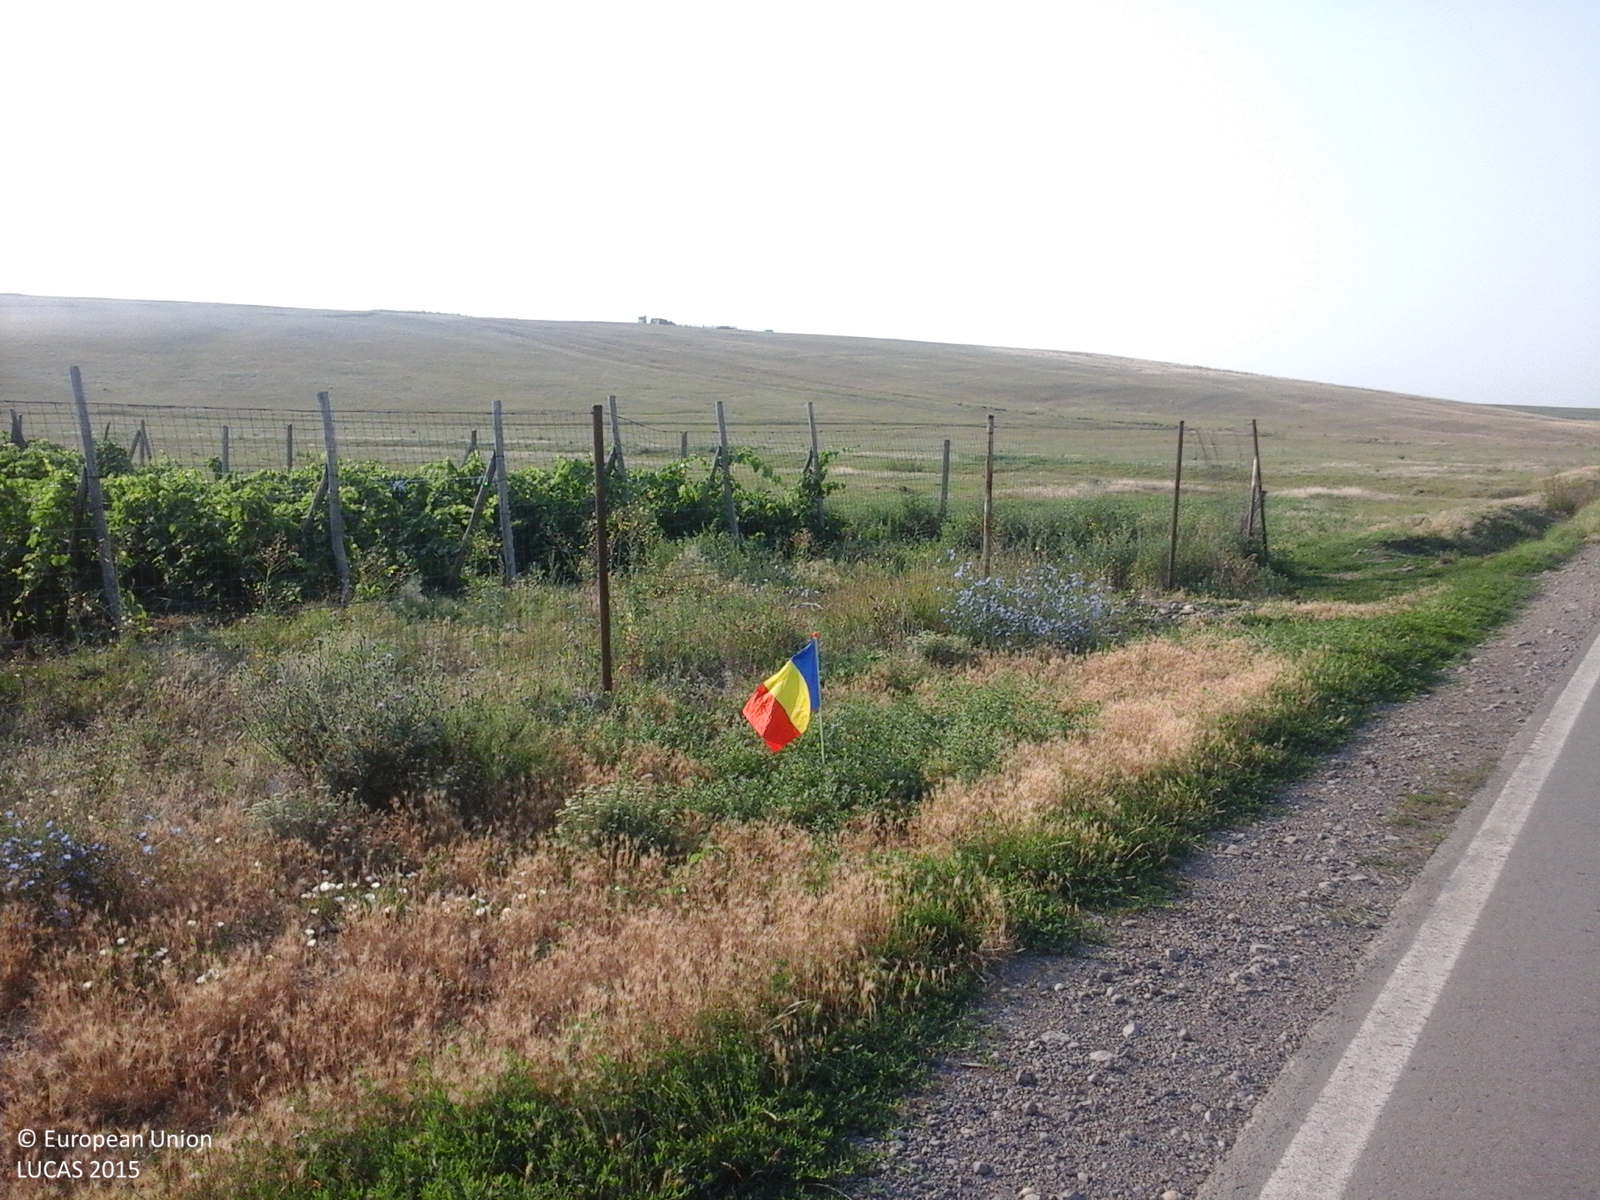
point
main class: Cropland
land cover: Vineyards
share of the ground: 50 - 75 %
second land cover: Grassland without tree/shrub cover
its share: > 75 %
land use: Agriculture (excluding fallow land and kitchen gardens)
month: July
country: RO
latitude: 45.7256
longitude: 27.7008
